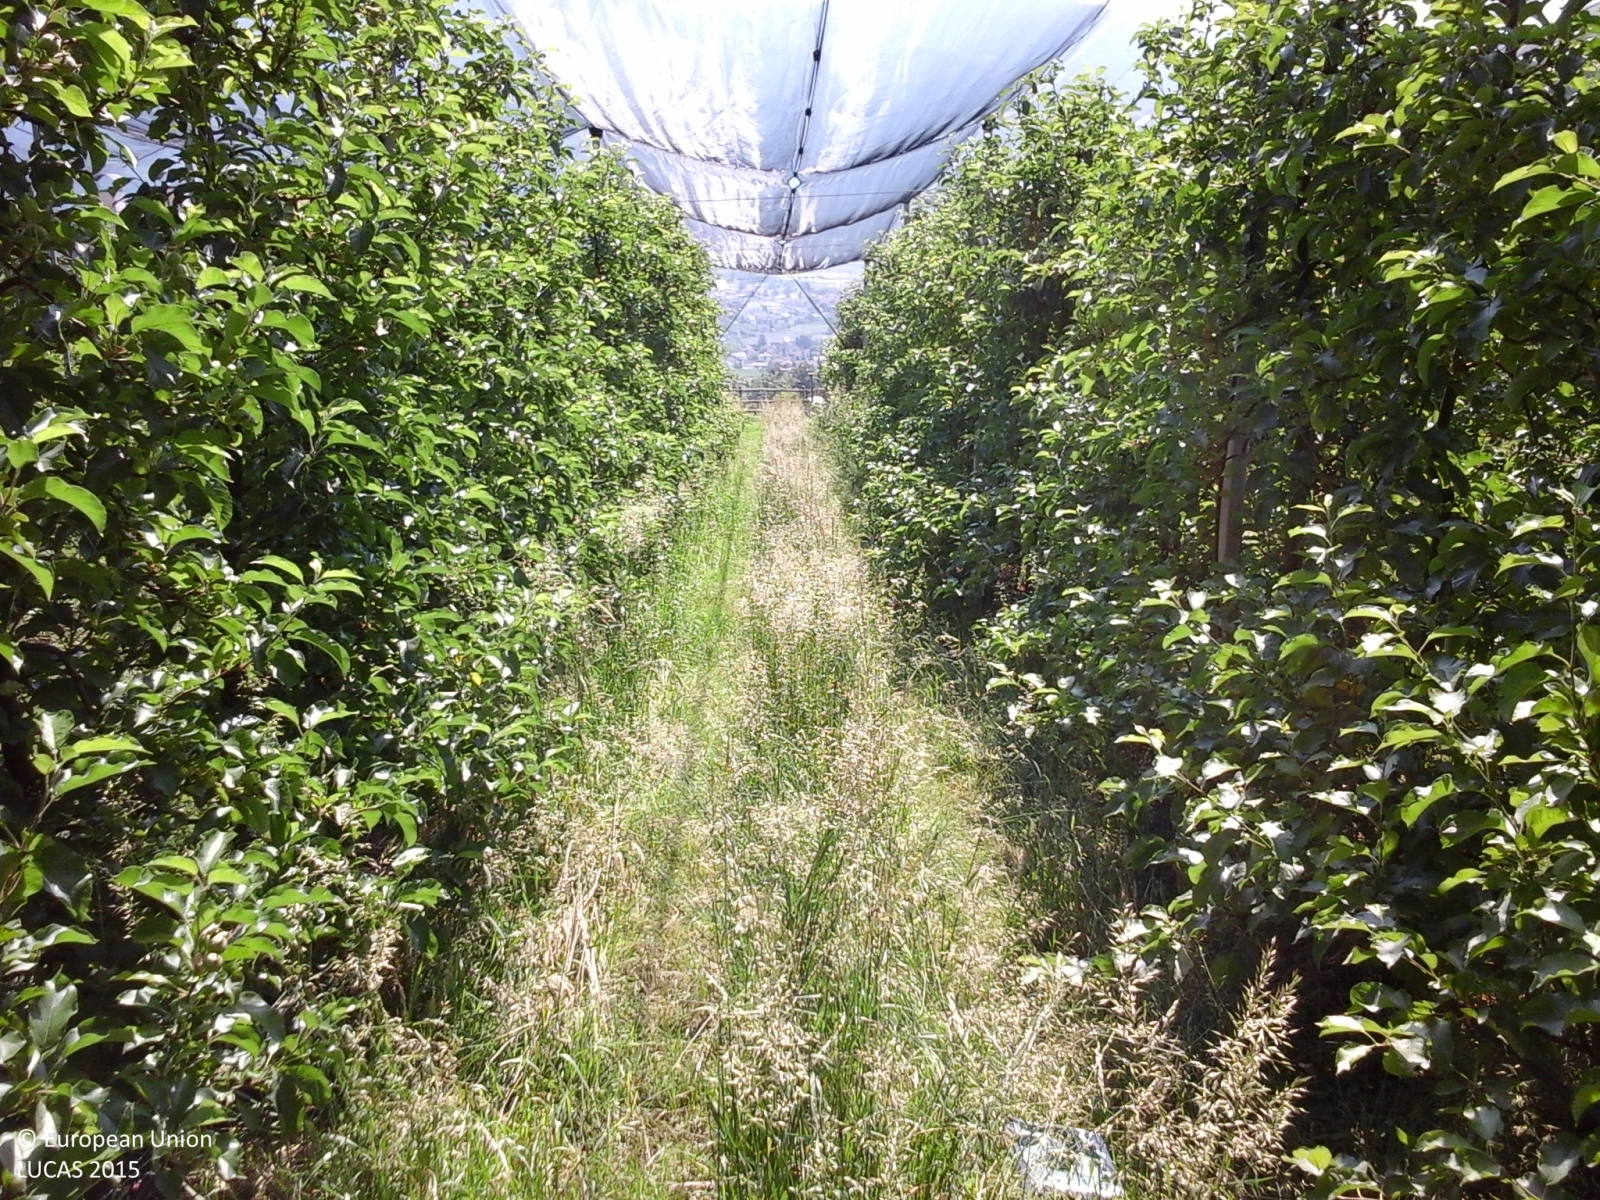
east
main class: Cropland
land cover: Apple fruit
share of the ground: > 75 %
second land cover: Grassland without tree/shrub cover
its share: > 75 %
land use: Agriculture (excluding fallow land and kitchen gardens)
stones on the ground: < 10 %
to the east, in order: Apple fruit; Grassland without tree/shrub cover; Artificial constructions in urban areas; Apple fruit; Tracks; Vineyards; Apple fruit; Tracks; Fences; Artificial constructions; Paved roads, cycling and walking lanes; Grassland without tree/shrub cover
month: May
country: IT
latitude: 46.6154
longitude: 11.1347
